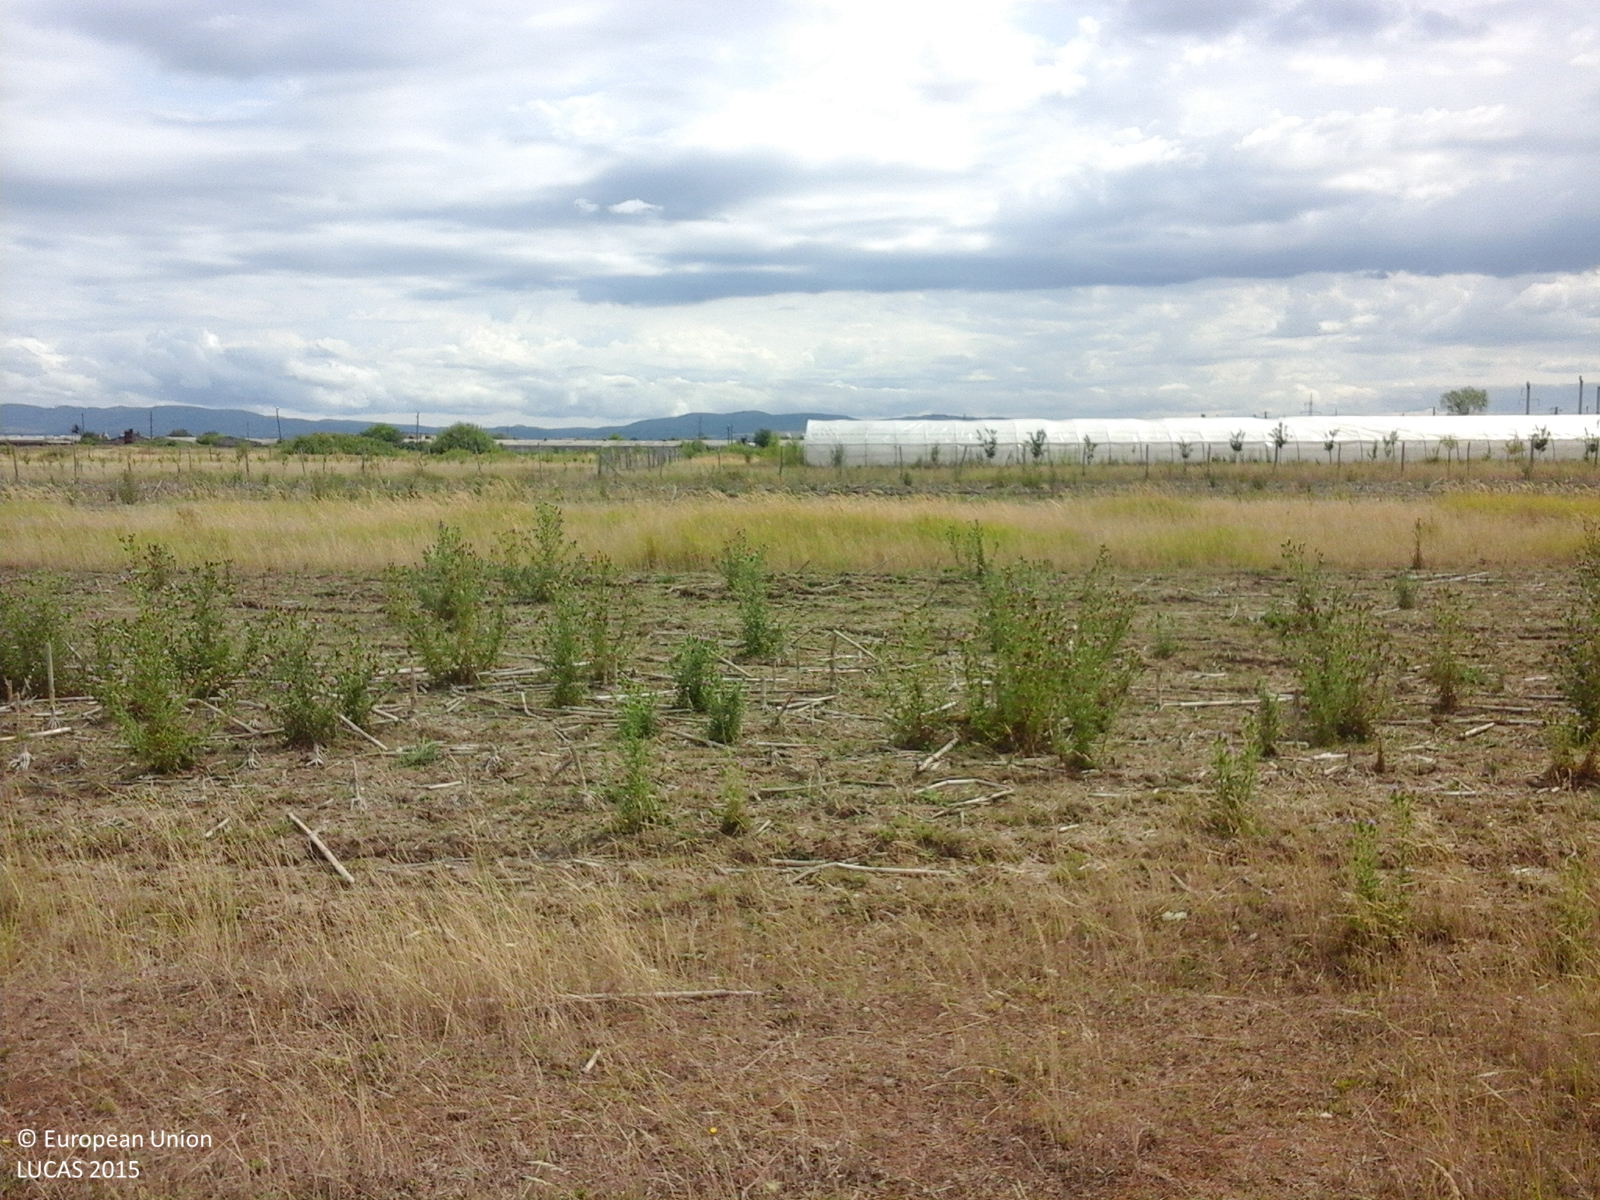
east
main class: Grassland
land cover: Grassland without tree/shrub cover
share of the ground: > 75 %
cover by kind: herbaceous plants 100 %
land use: Agriculture (excluding fallow land and kitchen gardens)
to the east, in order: Grassland without tree/shrub cover; Spontaneously vegetated surfaces; Grassland without tree/shrub cover; Spontaneously vegetated surfaces; Fences; Grassland with sparse tree/shrub cover; Fences; Grassland without tree/shrub cover; Tracks; Grassland without tree/shrub cover; Ditches and canals; Spontaneously vegetated surfaces
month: August
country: RO
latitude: 45.4267
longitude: 21.5999
